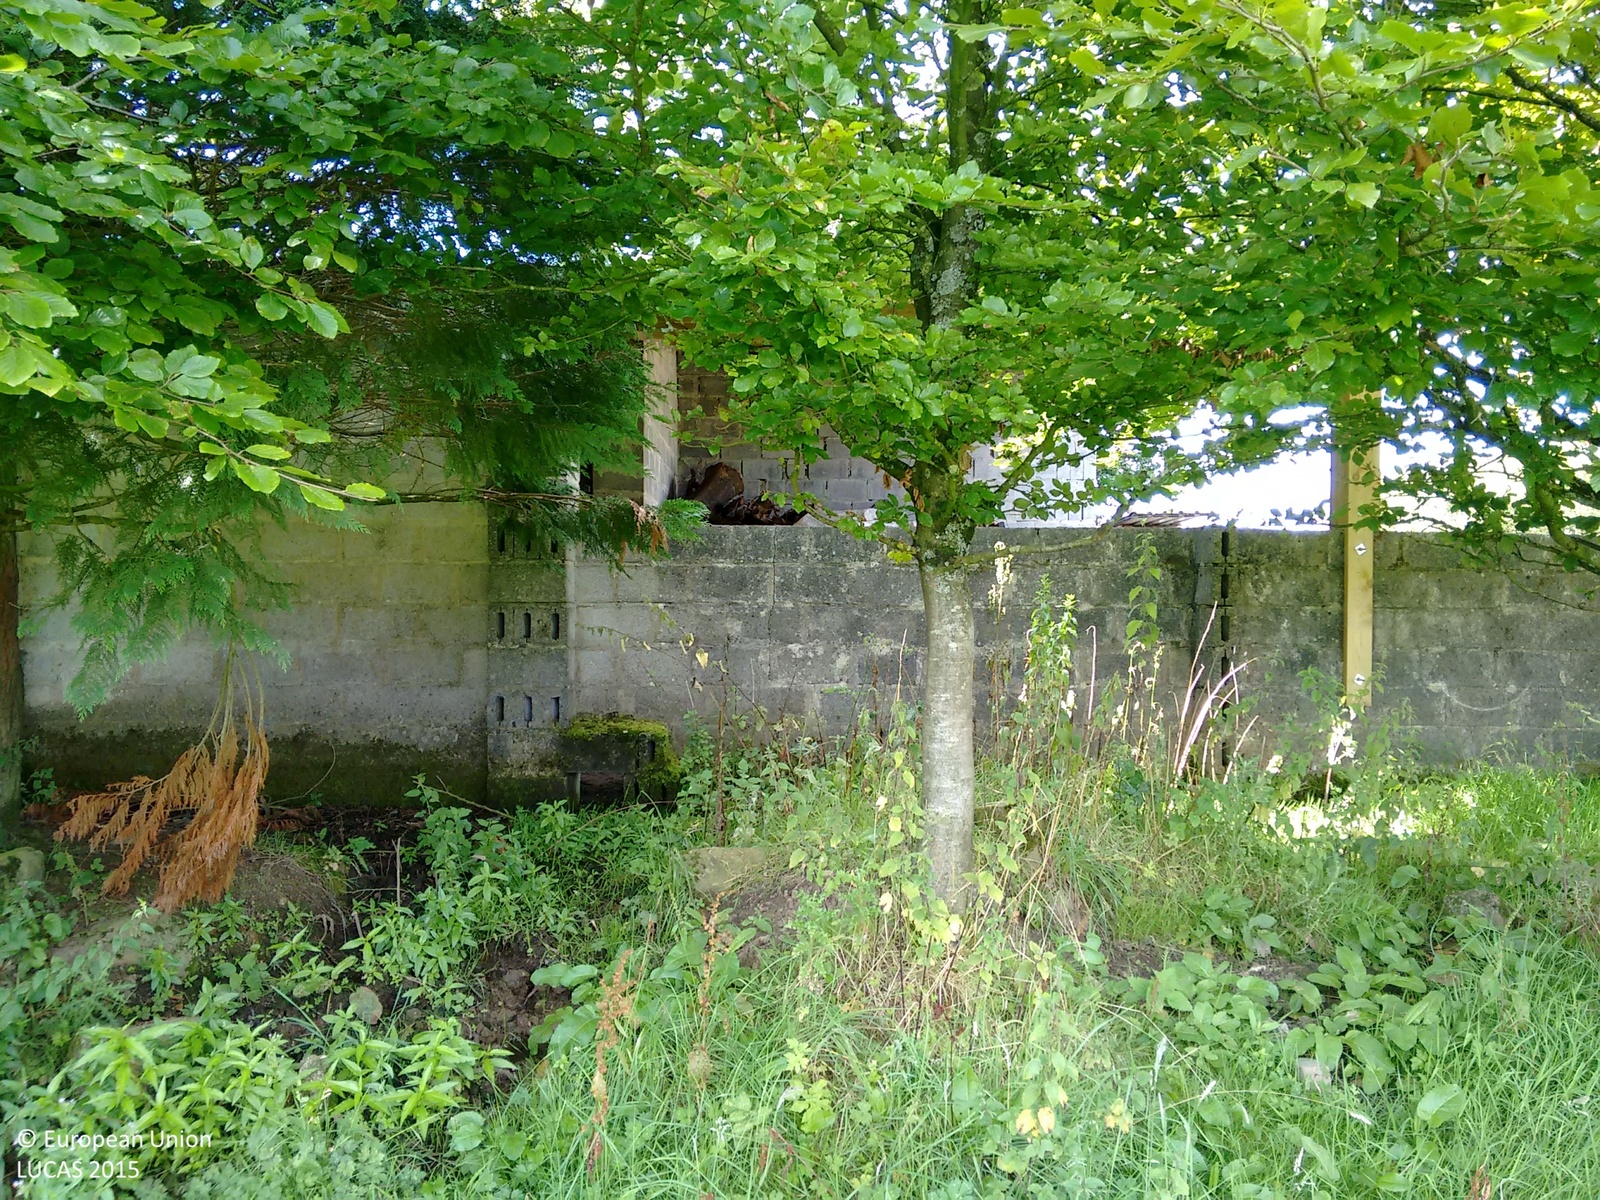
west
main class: Grassland
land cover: Grassland without tree/shrub cover
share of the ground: > 75 %
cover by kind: herbaceous plants 100 %
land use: Agriculture (excluding fallow land and kitchen gardens)
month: August
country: GB
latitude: 51.8229
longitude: -4.3940
